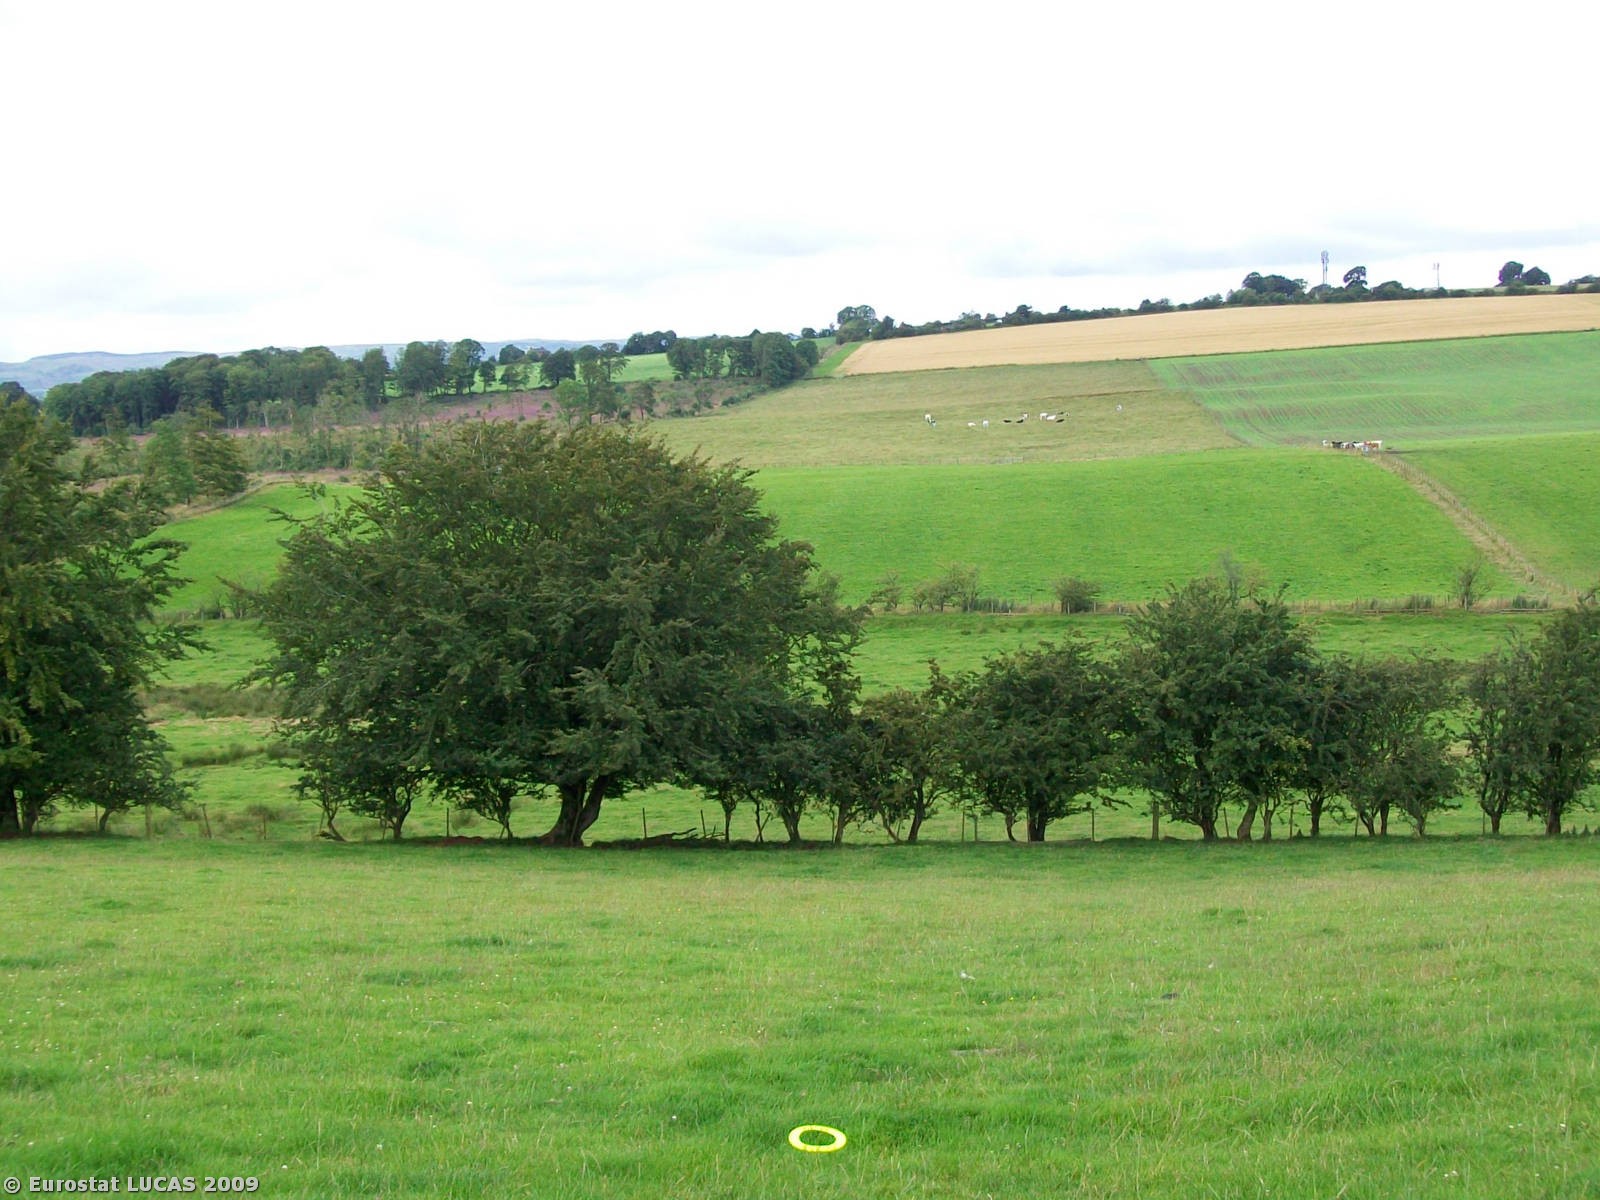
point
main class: Grassland
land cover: Grassland without tree/shrub cover
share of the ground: > 75 %
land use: Agriculture (excluding fallow land and kitchen gardens)
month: July
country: GB
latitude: 55.1553
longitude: -3.3702
